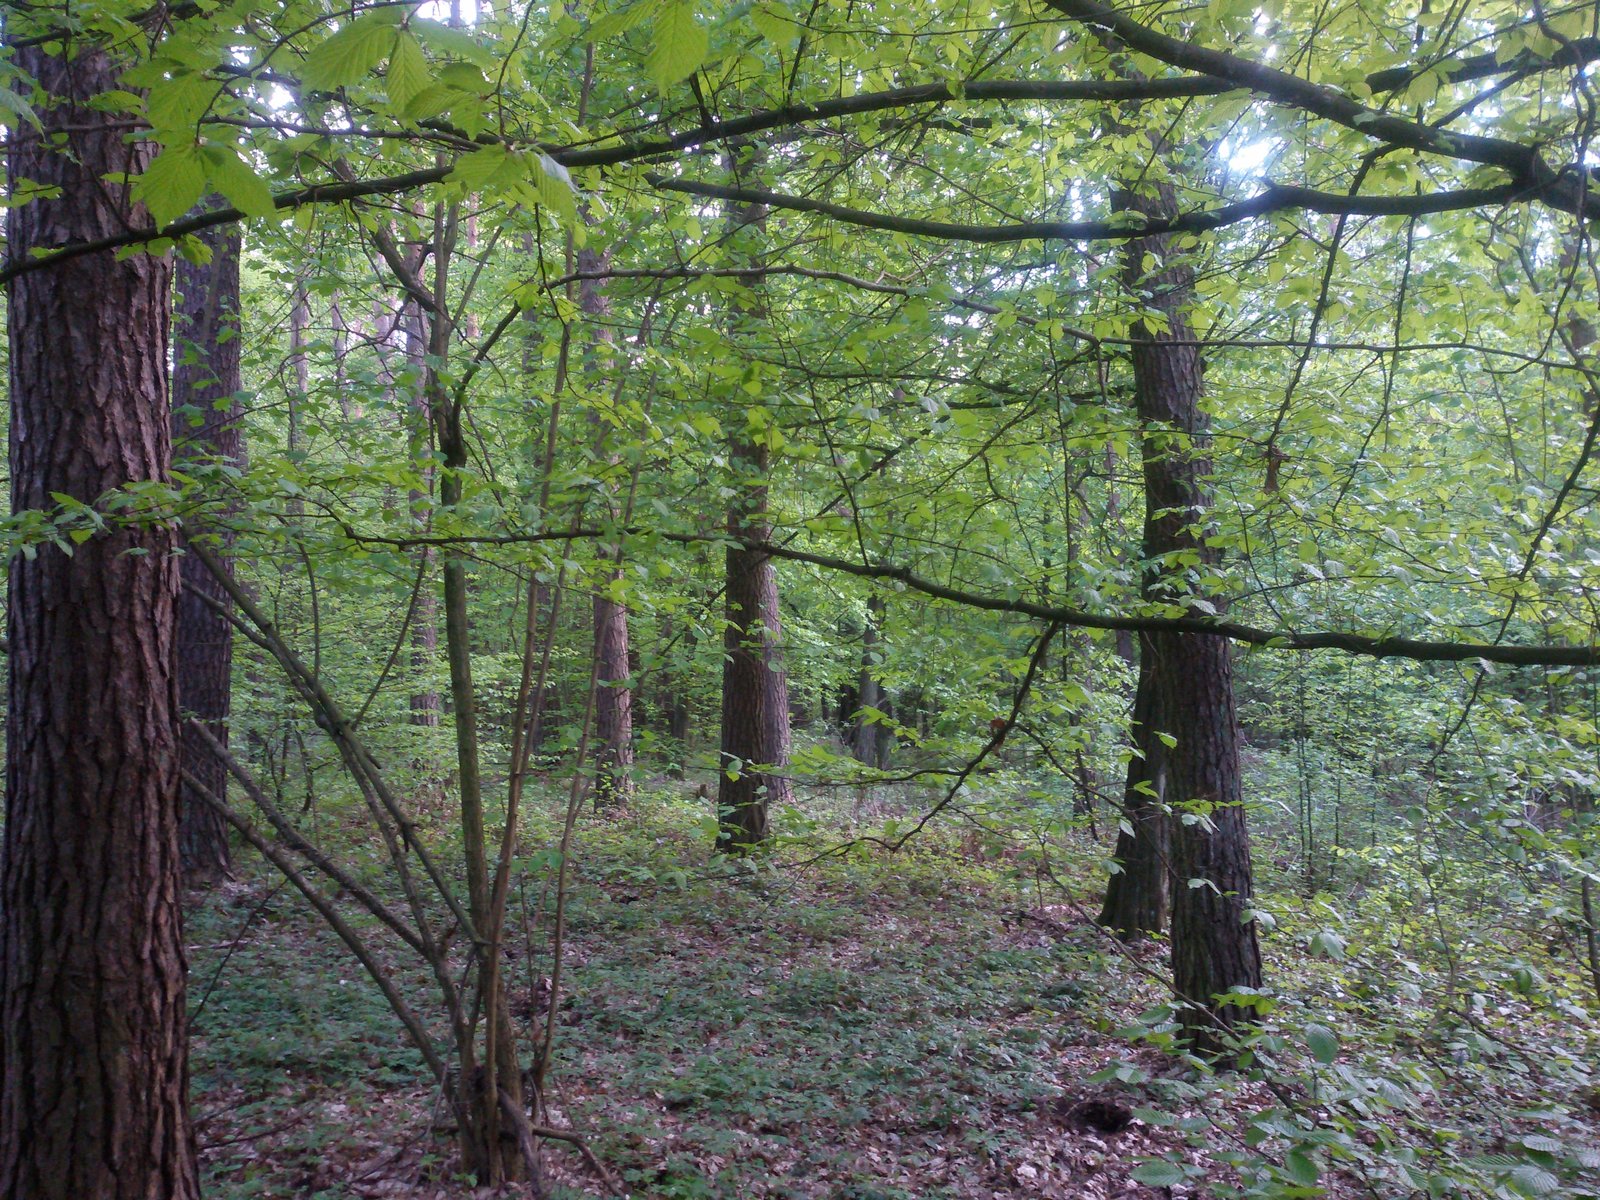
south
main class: Woodland
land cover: Pine dominated mixed woodland
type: hemiboreal forest and nemoral coniferous forest and mixed broadleaved-coniferous forest
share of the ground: > 75 %
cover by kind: coniferous forest trees 60 %, broadleaved forest trees 25 %, shrubs 10 %, herbaceous plants 5 %
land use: Forestry
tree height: > 5 m
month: February
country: PL
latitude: 51.4603
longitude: 21.6103
